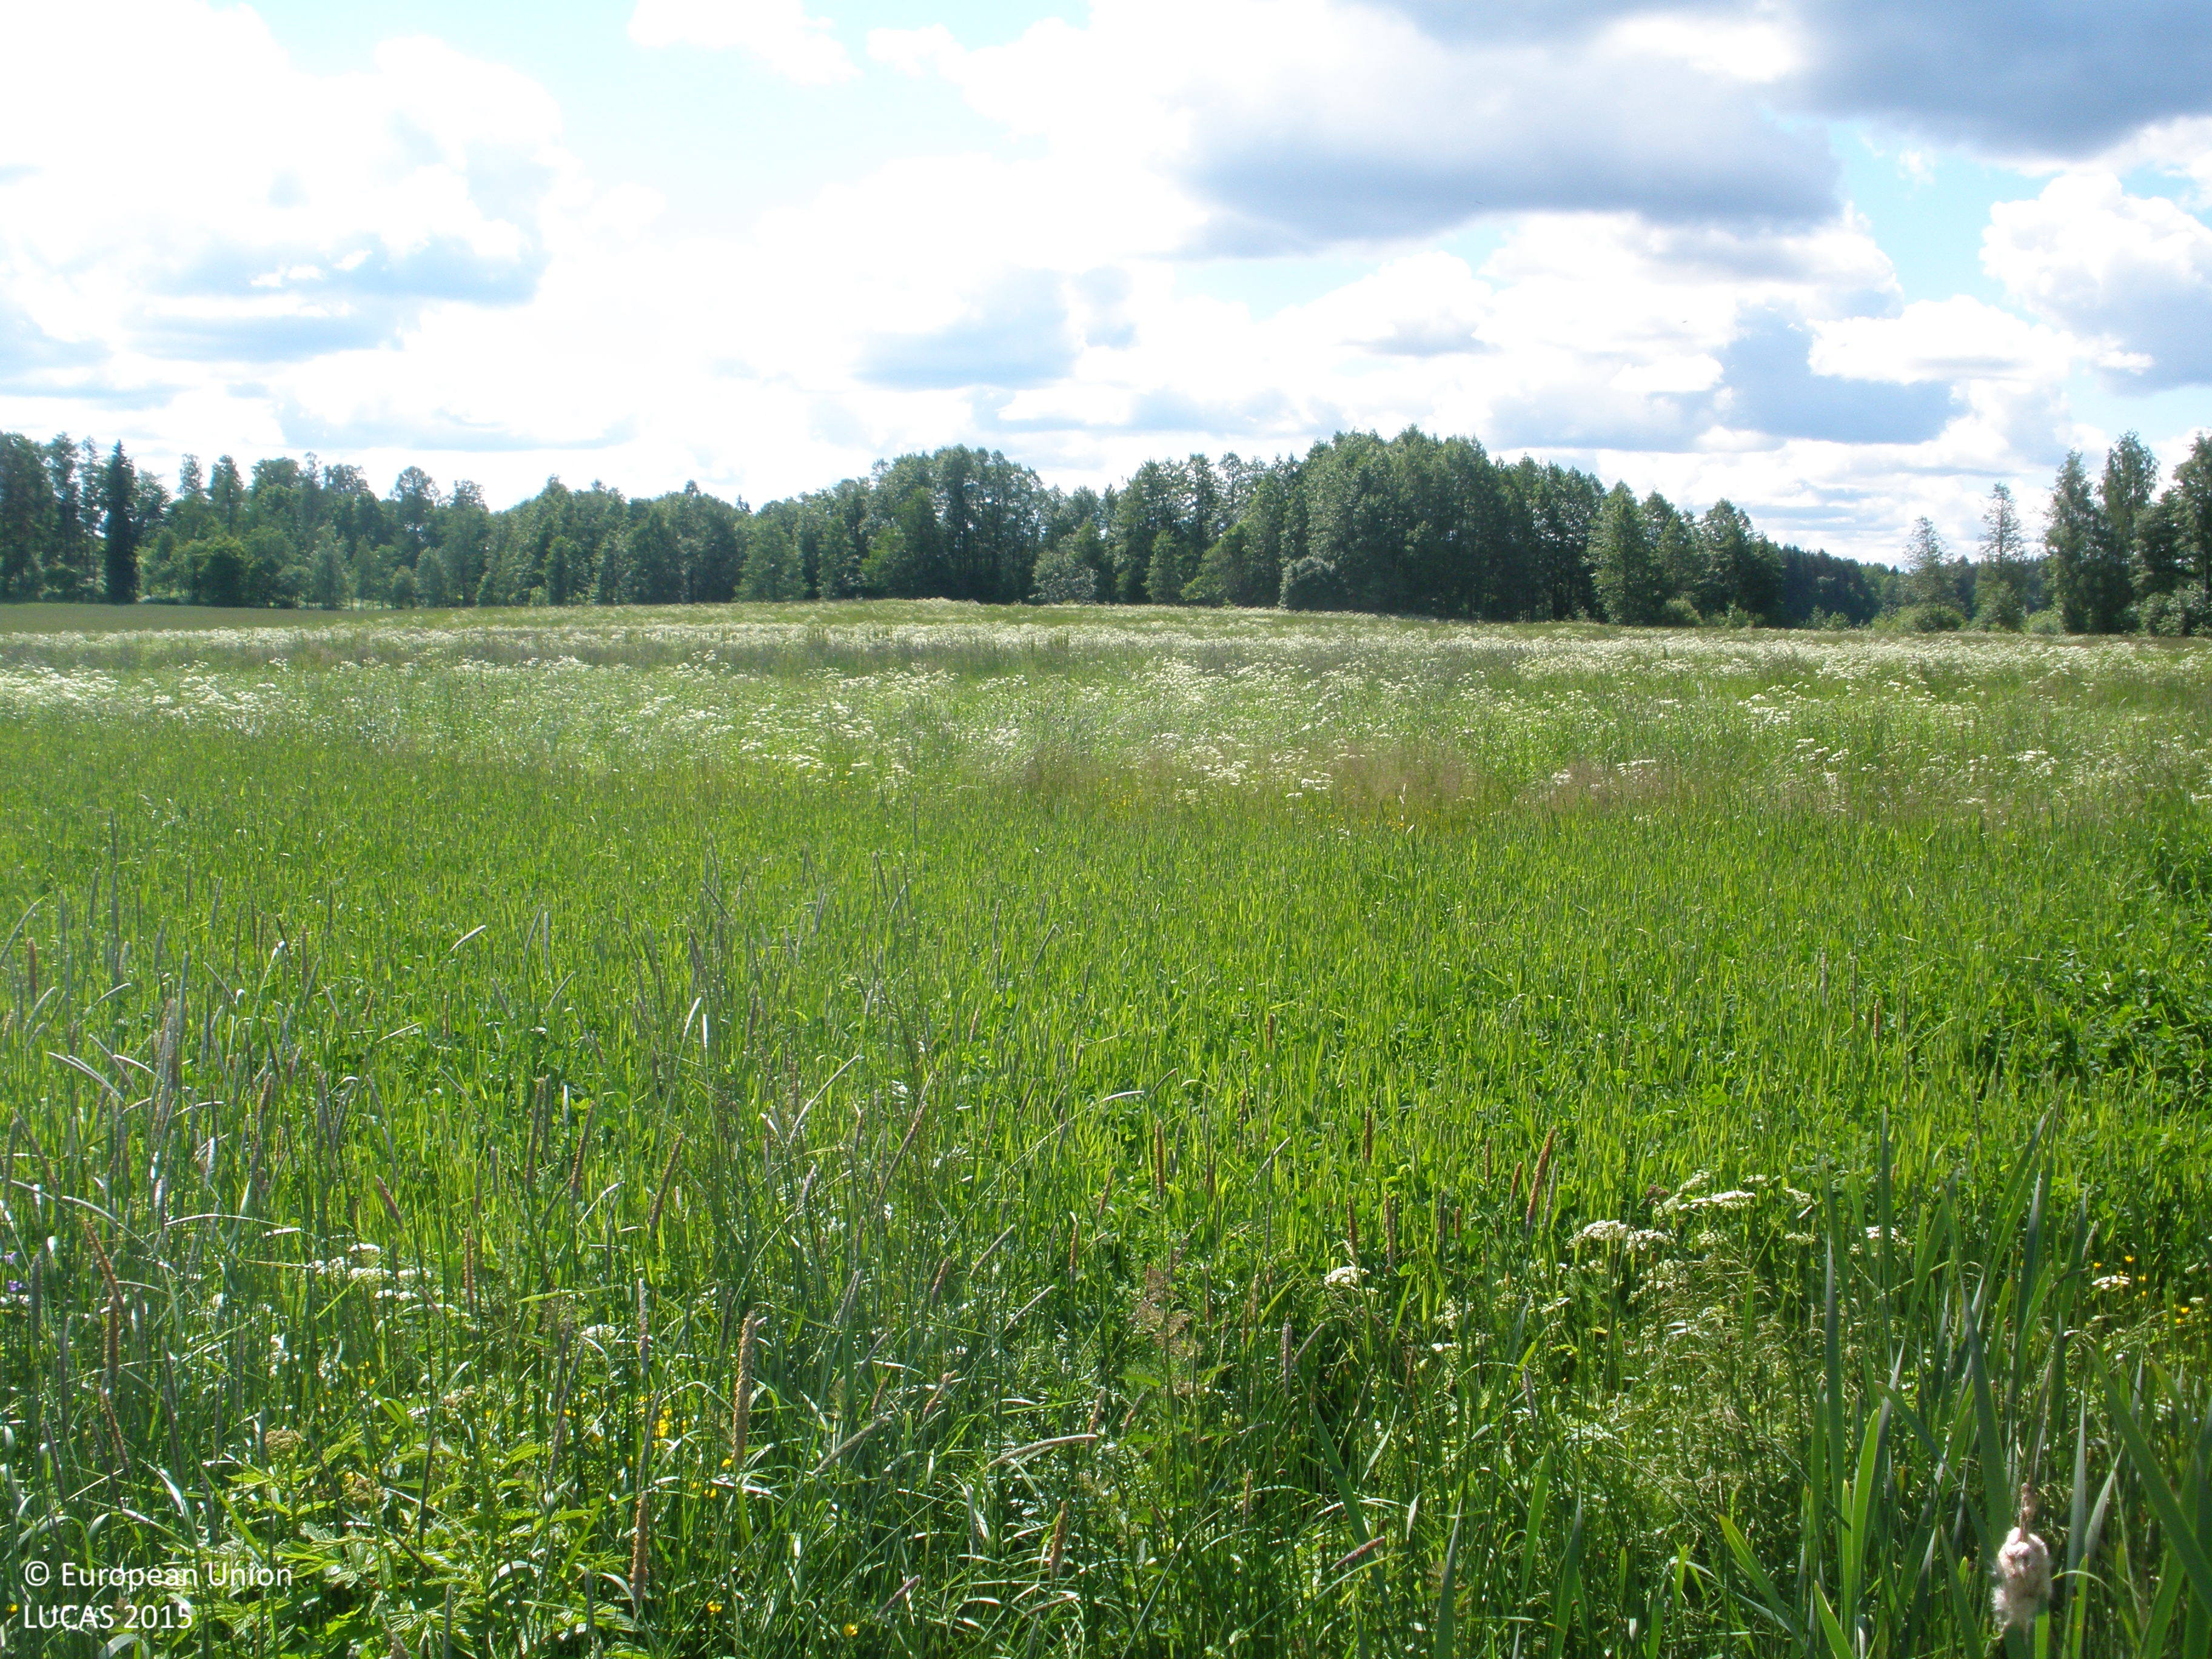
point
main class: Grassland
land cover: Grassland without tree/shrub cover
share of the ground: > 75 %
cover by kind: herbaceous plants 100 %
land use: Agriculture (excluding fallow land and kitchen gardens)
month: June
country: FI
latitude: 61.0751
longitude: 24.1628
